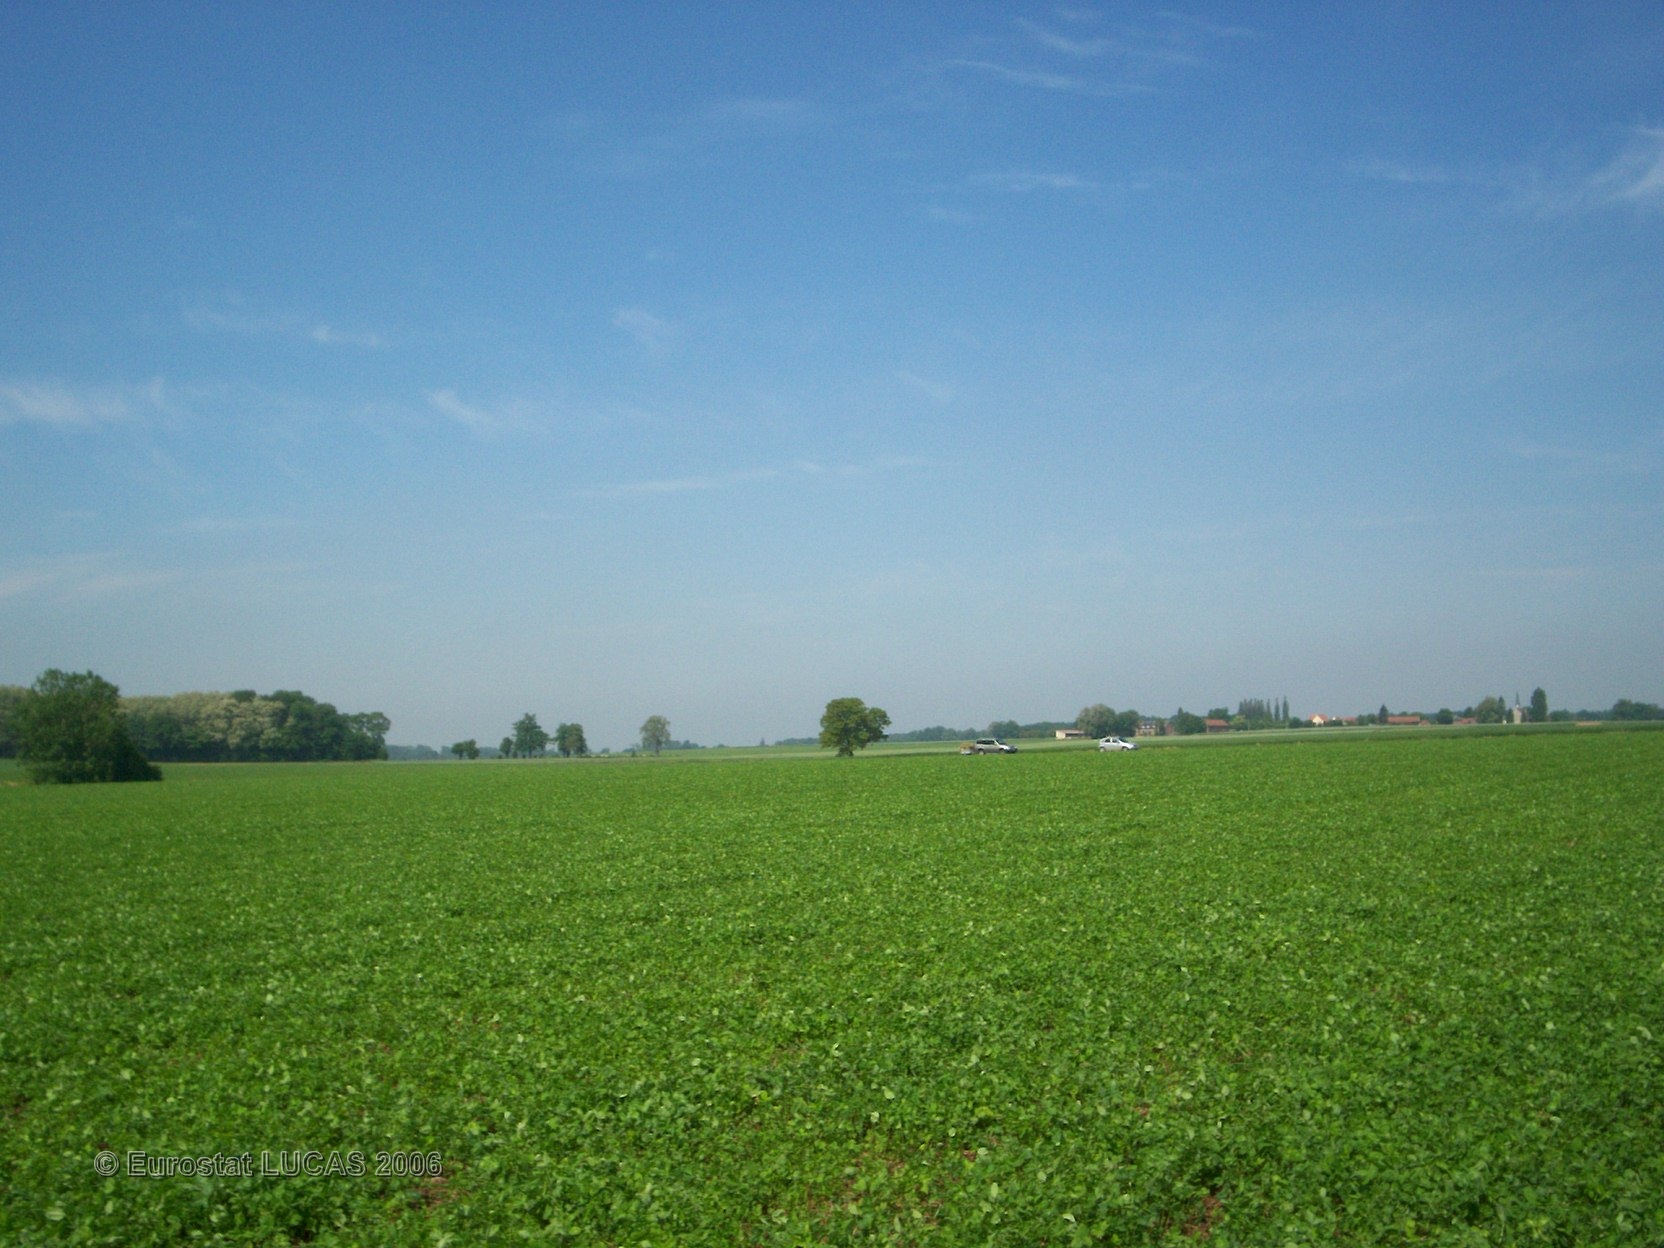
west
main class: Cropland
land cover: Clovers
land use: Agriculture (excluding fallow land and kitchen gardens)
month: June
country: FR
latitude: 49.5889
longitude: 2.6989
